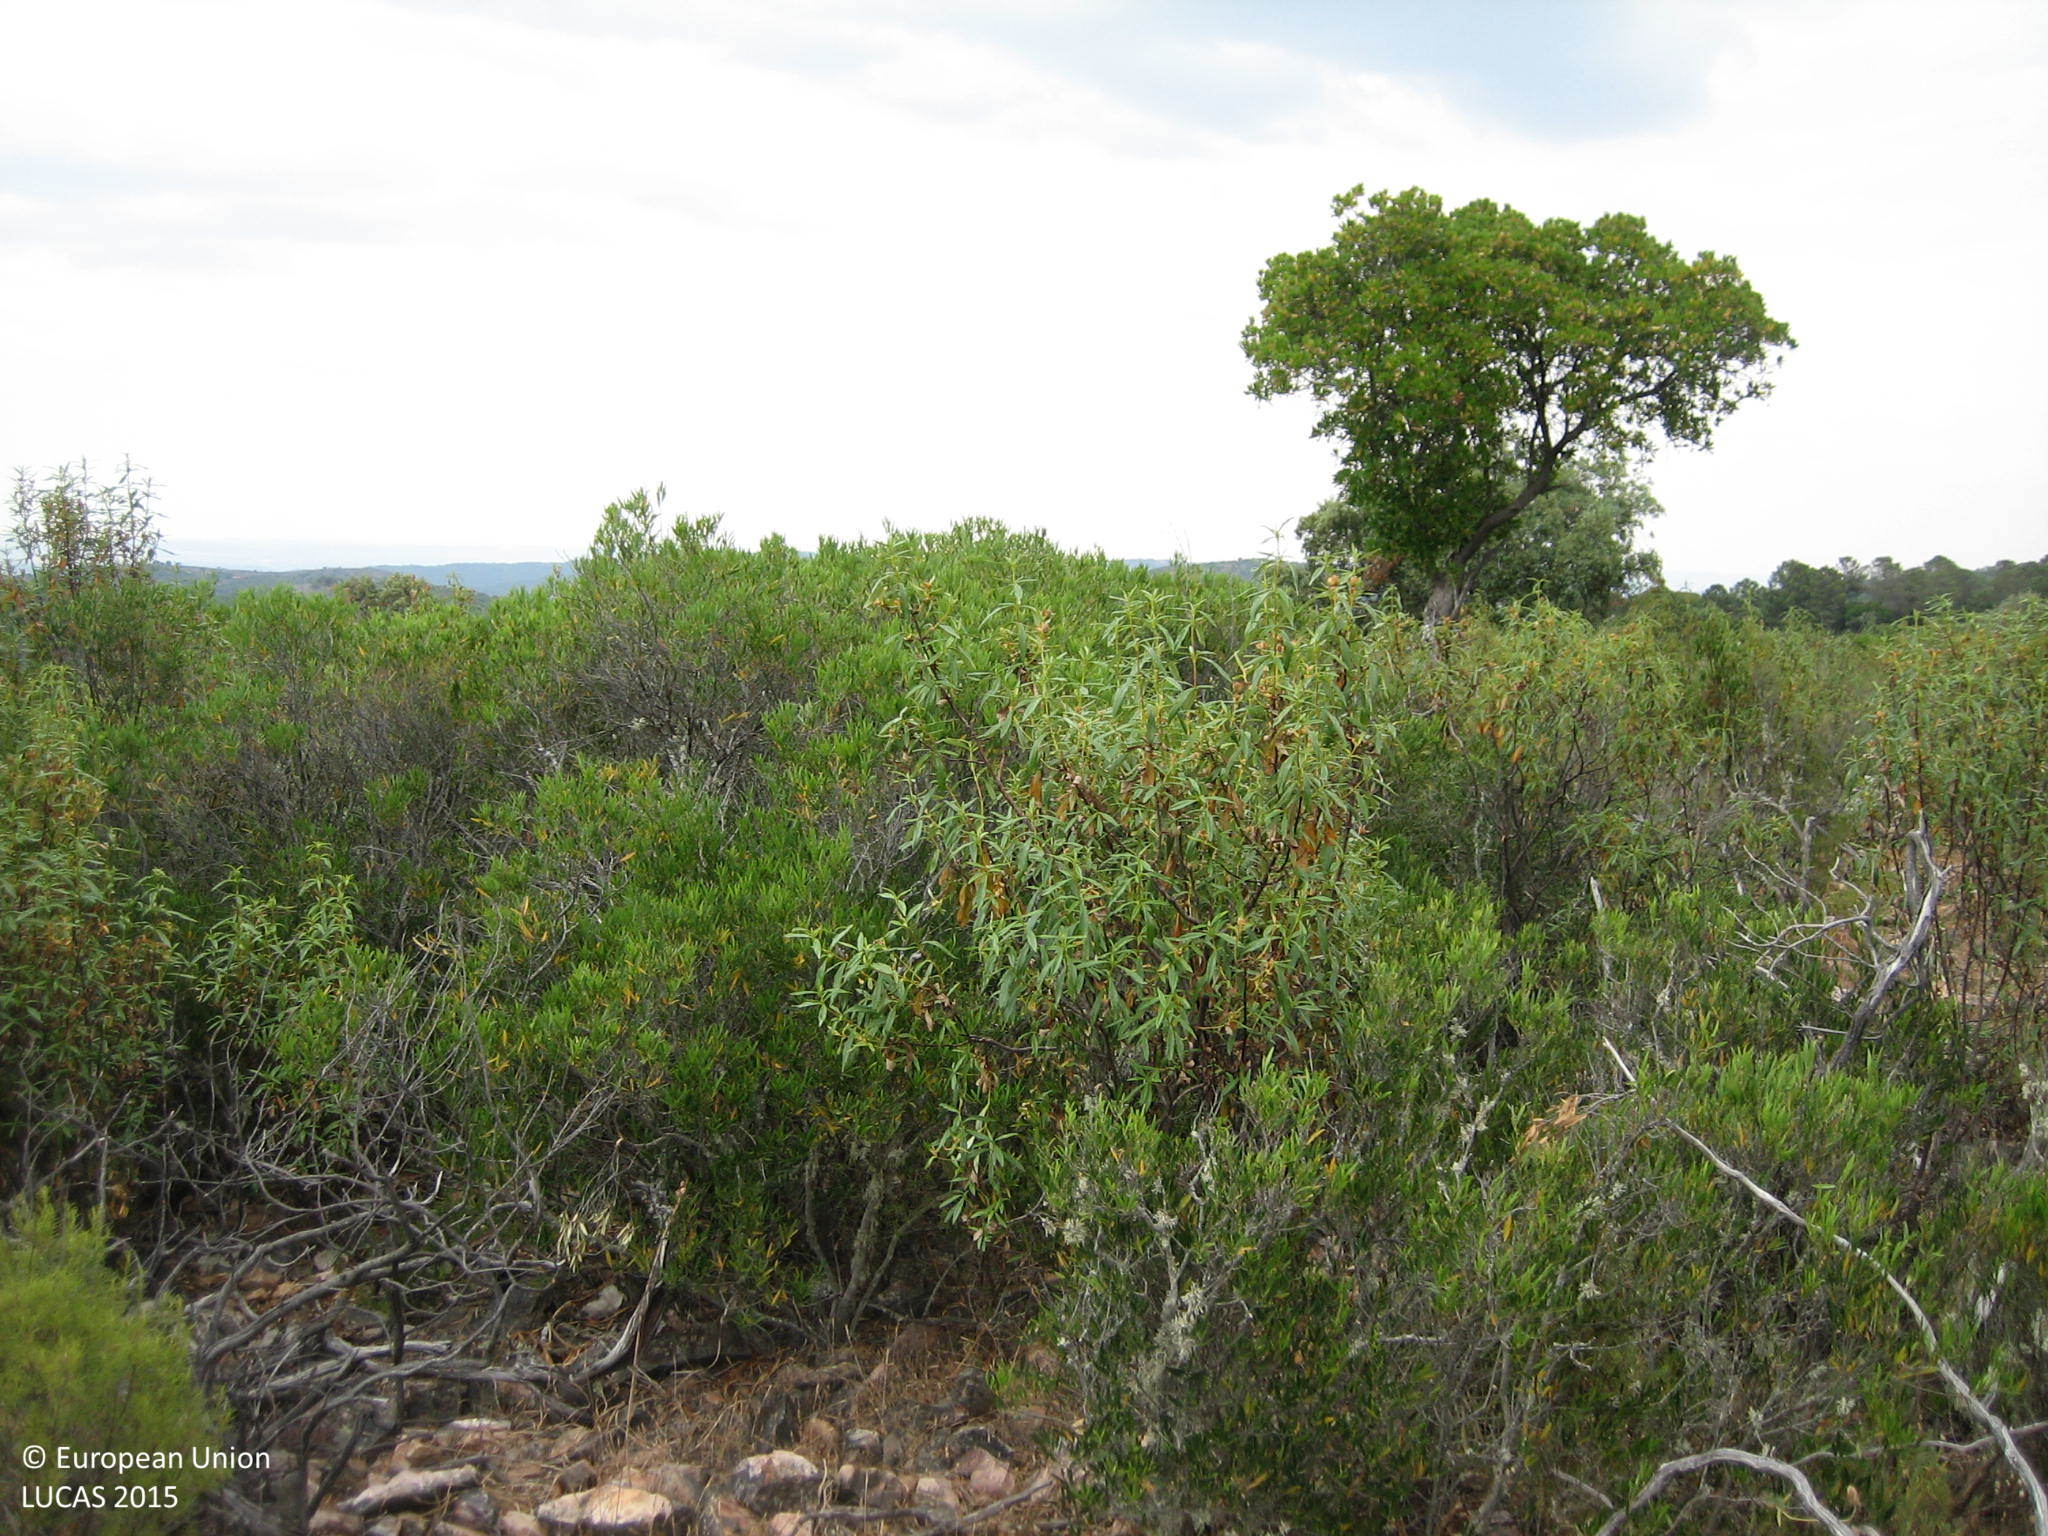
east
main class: Shrubland
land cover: Shrubland without tree cover
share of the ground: > 75 %
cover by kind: shrubs 100 %
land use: Semi-natural and natural areas not in use
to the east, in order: Shrubland without tree cover; Shrubland with sparse tree cover; Broadleaved woodland; Tracks; Broadleaved woodland
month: June
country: ES
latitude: 39.2857
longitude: -4.9132
